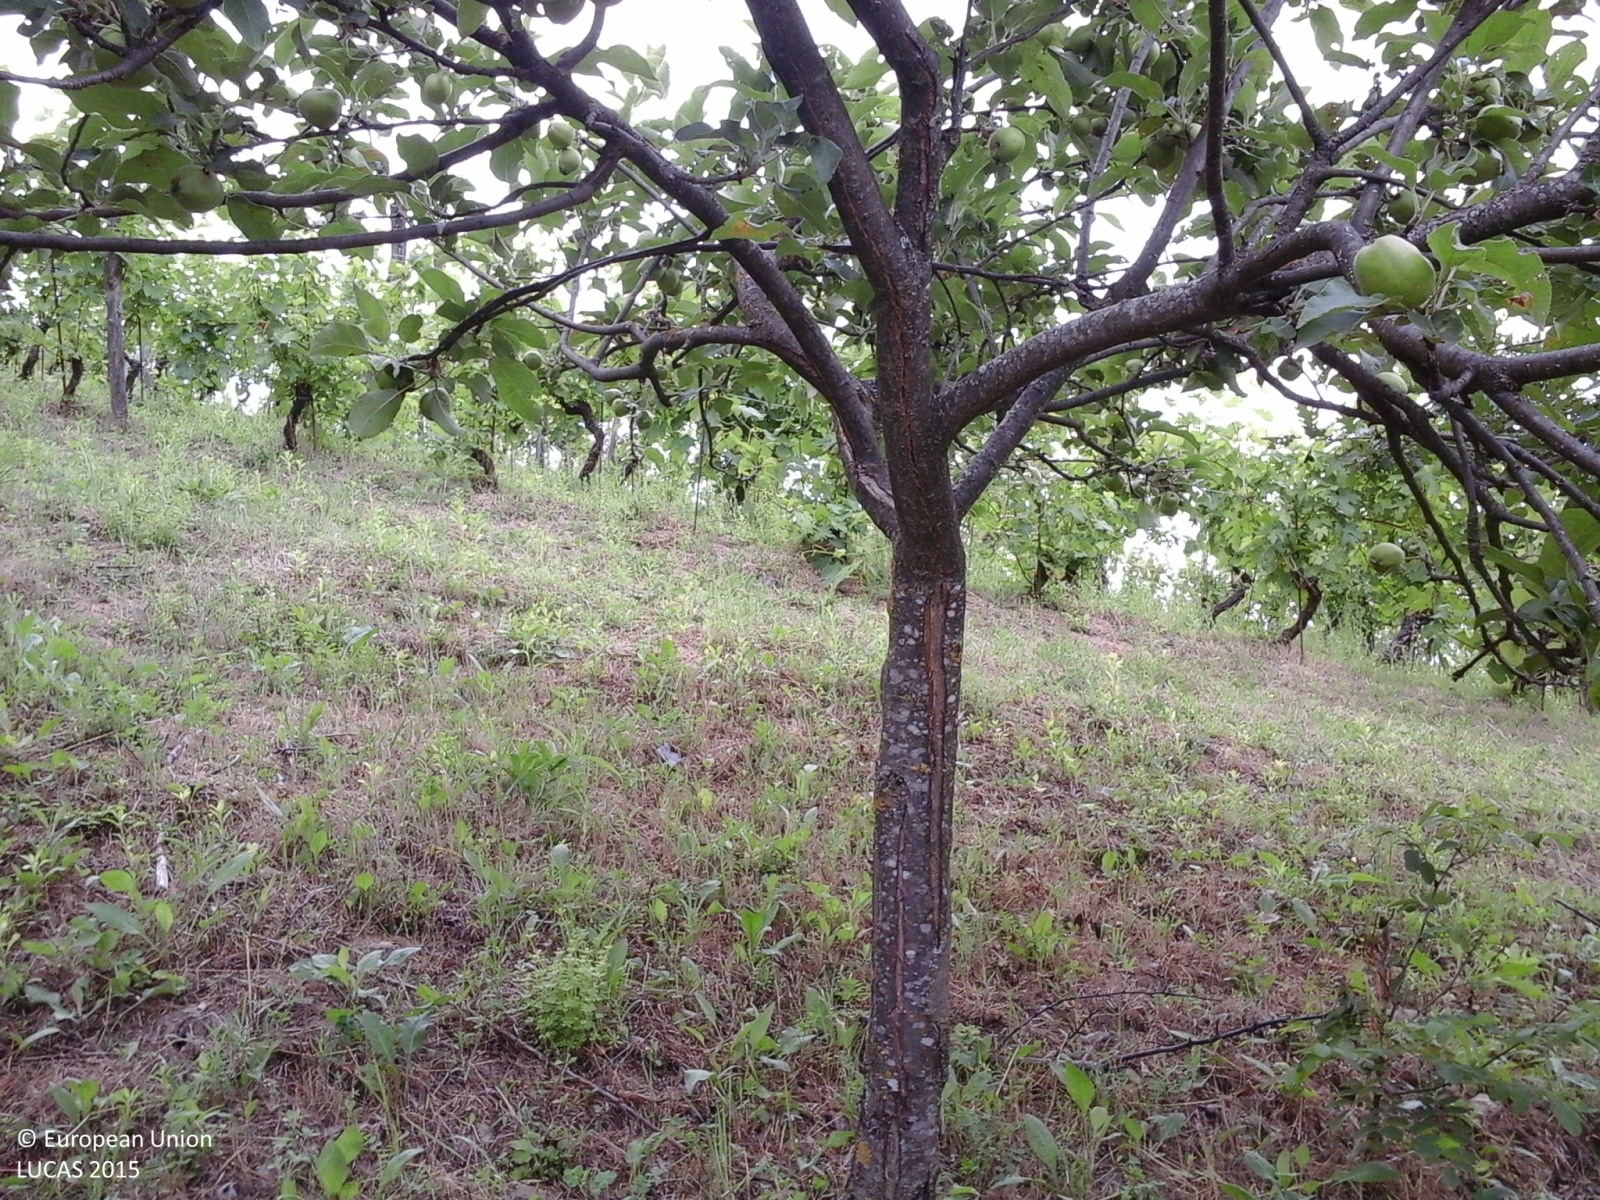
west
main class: Cropland
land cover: Pear fruit
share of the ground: 10 - 25 %
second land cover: Apple fruit
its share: 10 - 25 %
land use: Agriculture (excluding fallow land and kitchen gardens)
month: June
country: IT
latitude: 44.8548
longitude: 9.6338
